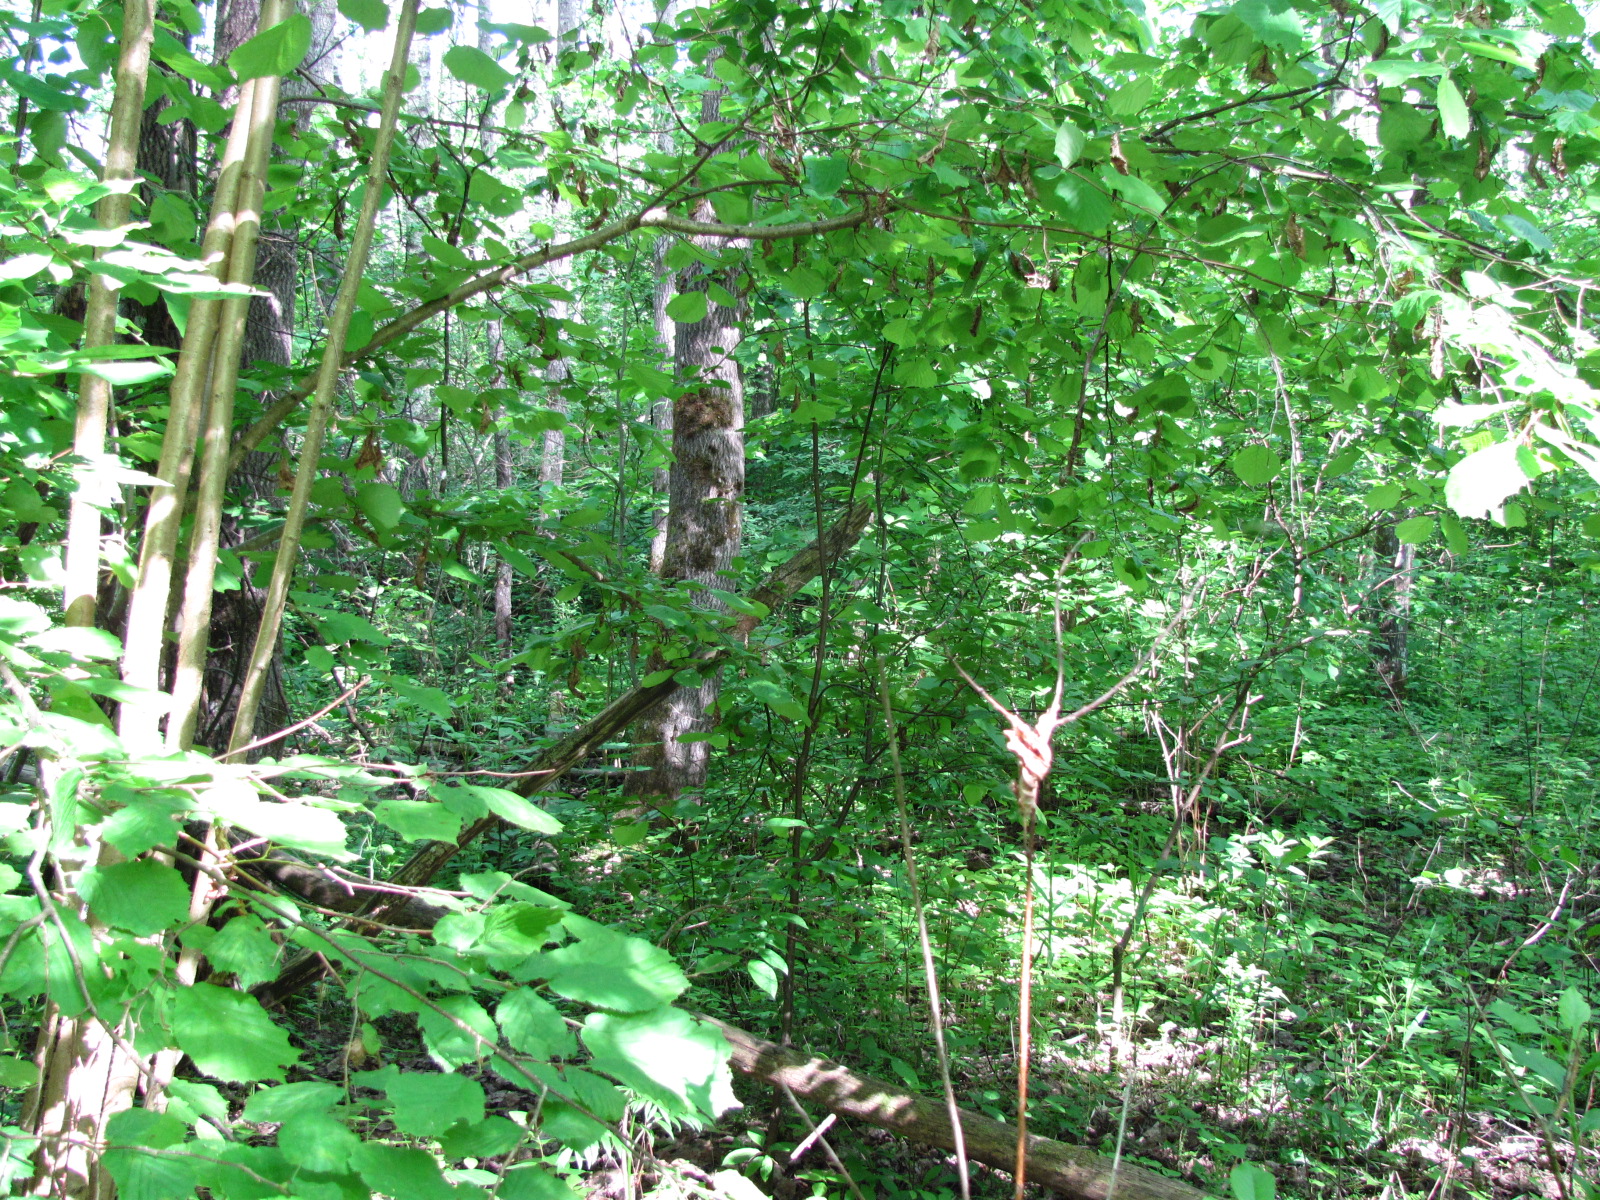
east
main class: Woodland
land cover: Broadleaved woodland
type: non-riverine alder, birch or aspen forest
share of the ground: > 75 %
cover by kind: broadleaved forest trees 100 %
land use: Forestry
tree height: > 5 m
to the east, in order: Broadleaved woodland; Spontaneously vegetated surfaces; Tracks; Spontaneously vegetated surfaces; Electric lines; Spontaneously vegetated surfaces; Tracks; Spontaneously vegetated surfaces; Broadleaved woodland; Spontaneously vegetated surfaces; Tracks; Spontaneously vegetated surfaces; Electric lines; Tracks; Spontaneously vegetated surfaces; Broadleaved woodland; Grassland with sparse tree/shrub cover
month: June
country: LV
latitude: 56.8725
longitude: 24.3818
